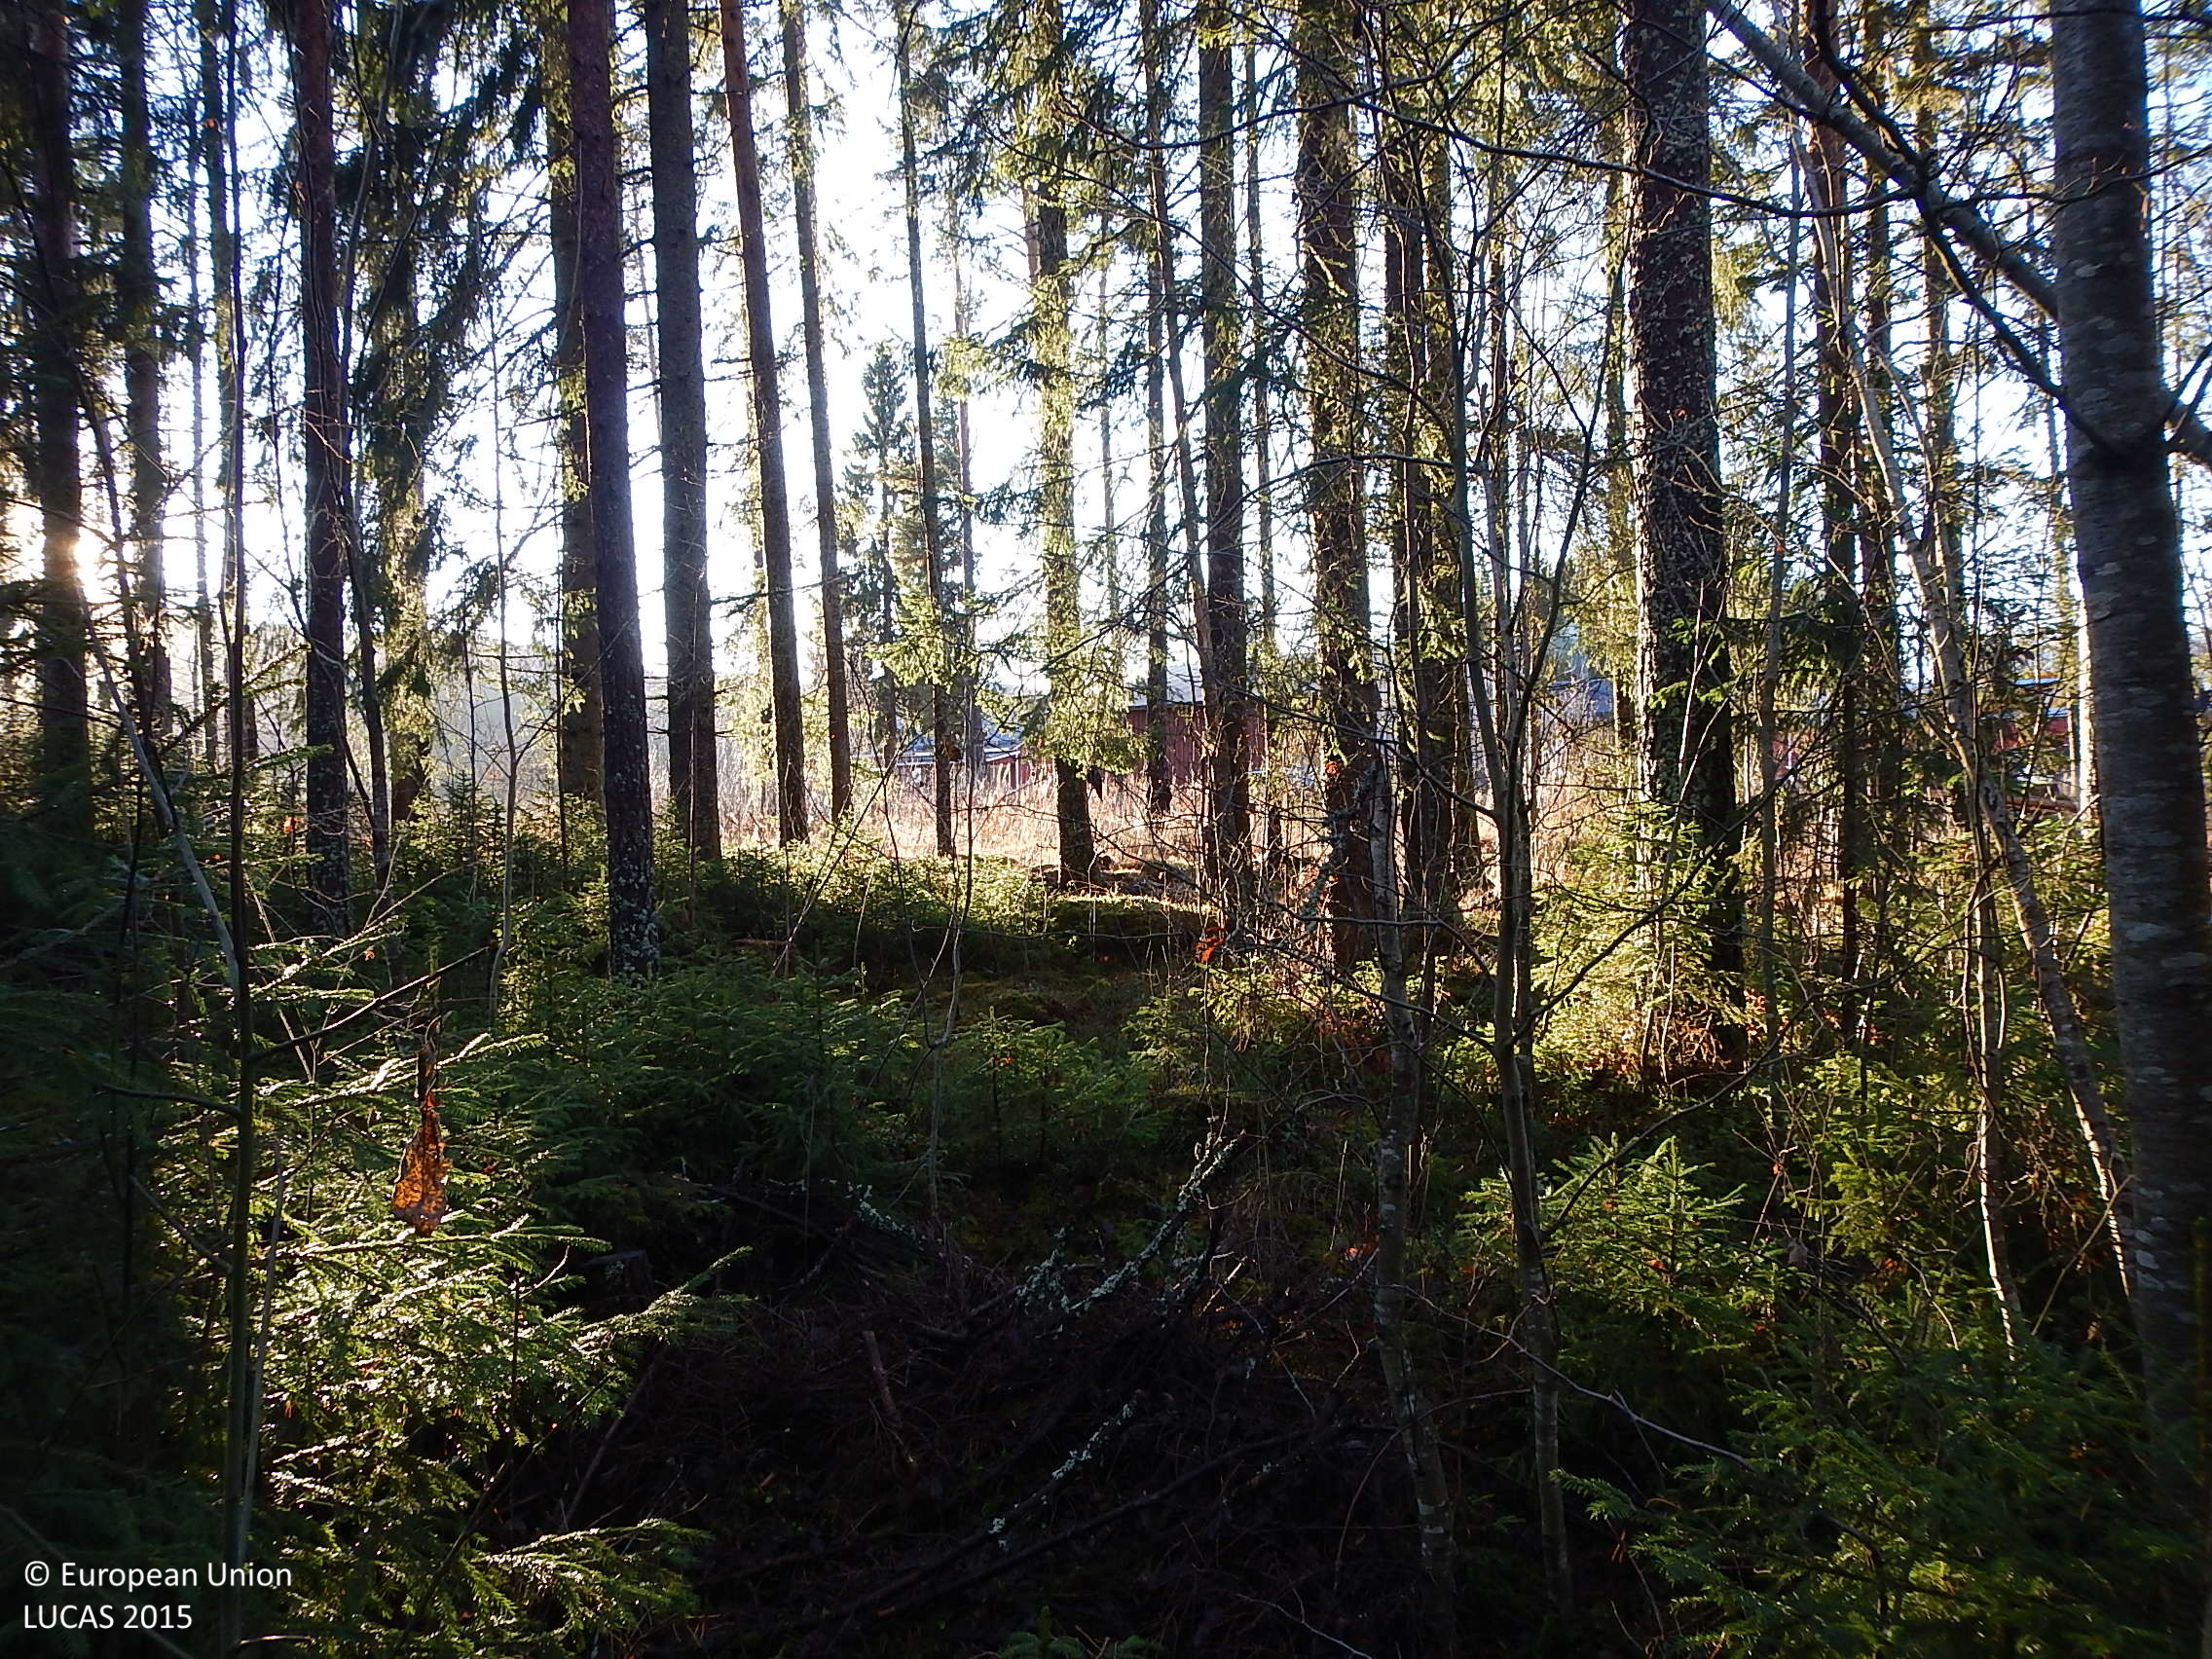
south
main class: Woodland
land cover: Other coniferous woodland
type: boreal forest
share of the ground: 50 - 75 %
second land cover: Grassland without tree/shrub cover
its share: 25 - 50 %
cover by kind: coniferous forest trees 60 %, herbaceous plants 20 %, broadleaved forest trees 10 %, shrubs 5 %, lichens and mosses 5 %
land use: Forestry
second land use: Agriculture (excluding fallow land and kitchen gardens)
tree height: > 5 m
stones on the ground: < 10 %
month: November
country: SE
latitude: 61.7294
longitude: 16.0960
